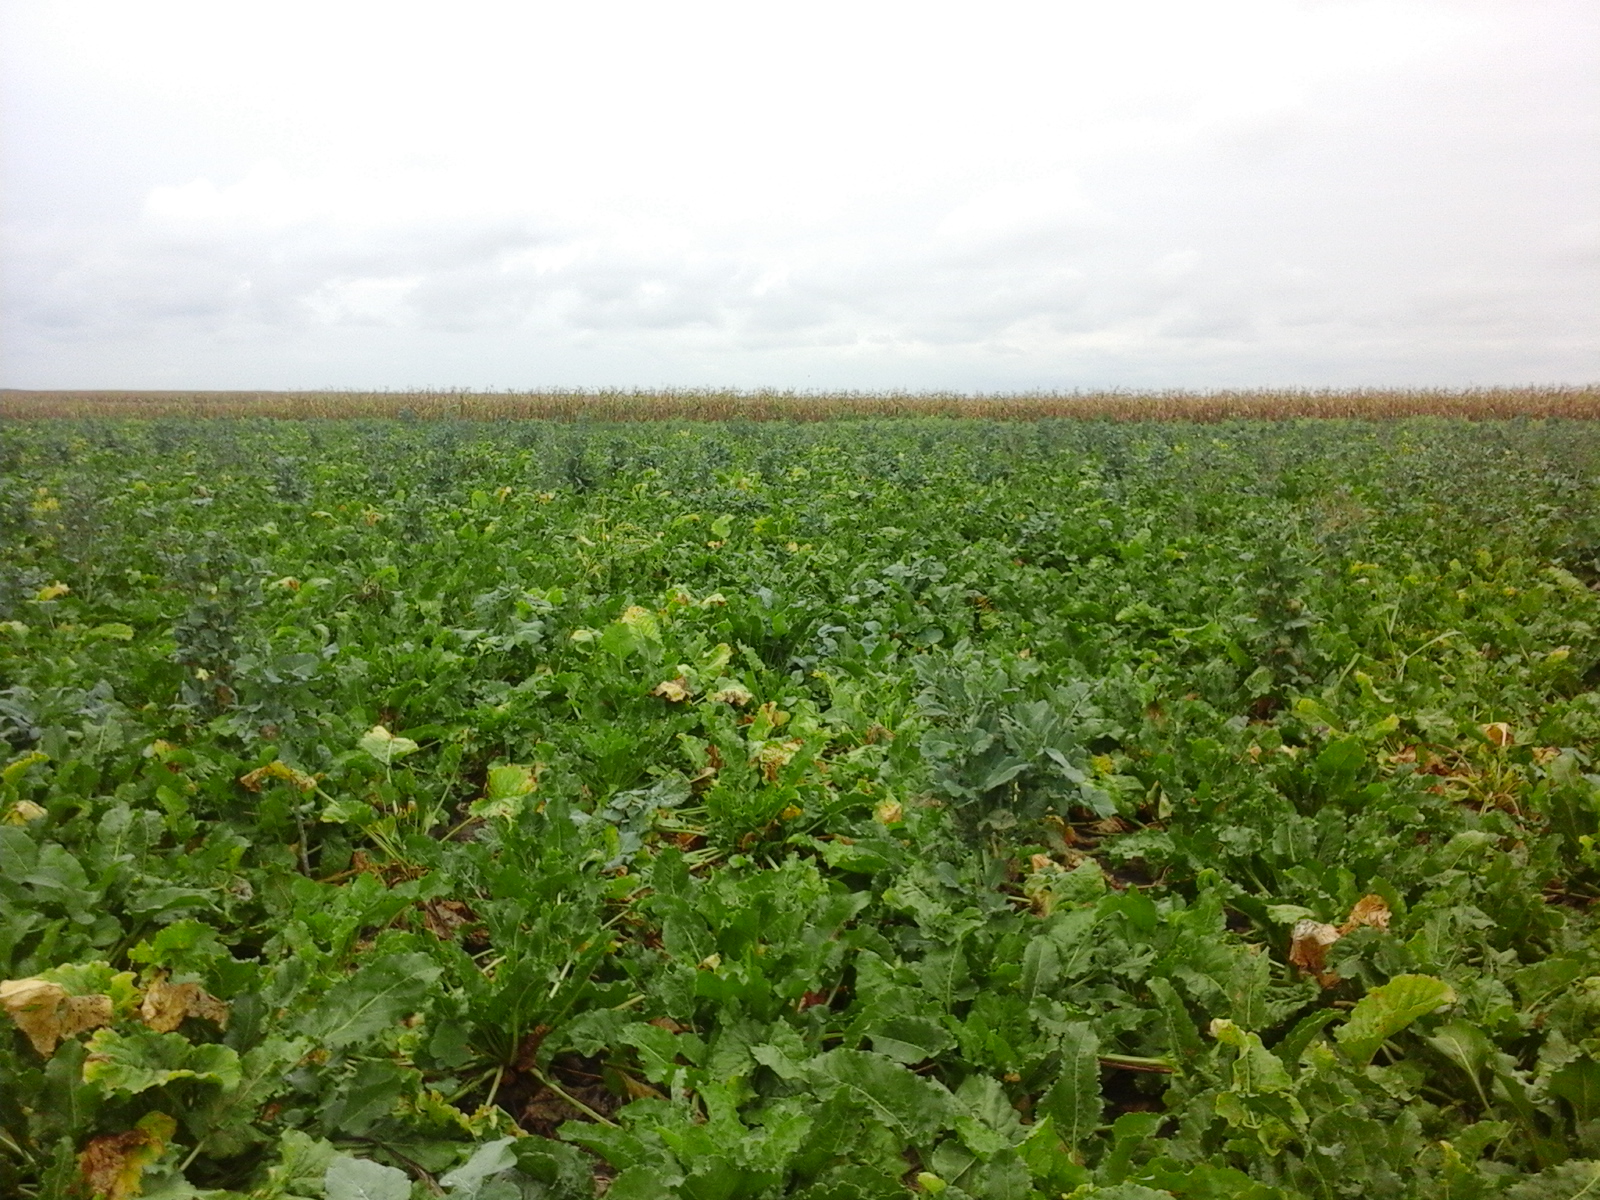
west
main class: Cropland
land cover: Sugar beet
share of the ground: > 75 %
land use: Agriculture (excluding fallow land and kitchen gardens)
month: September
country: RO
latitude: 47.1959
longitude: 21.8863
